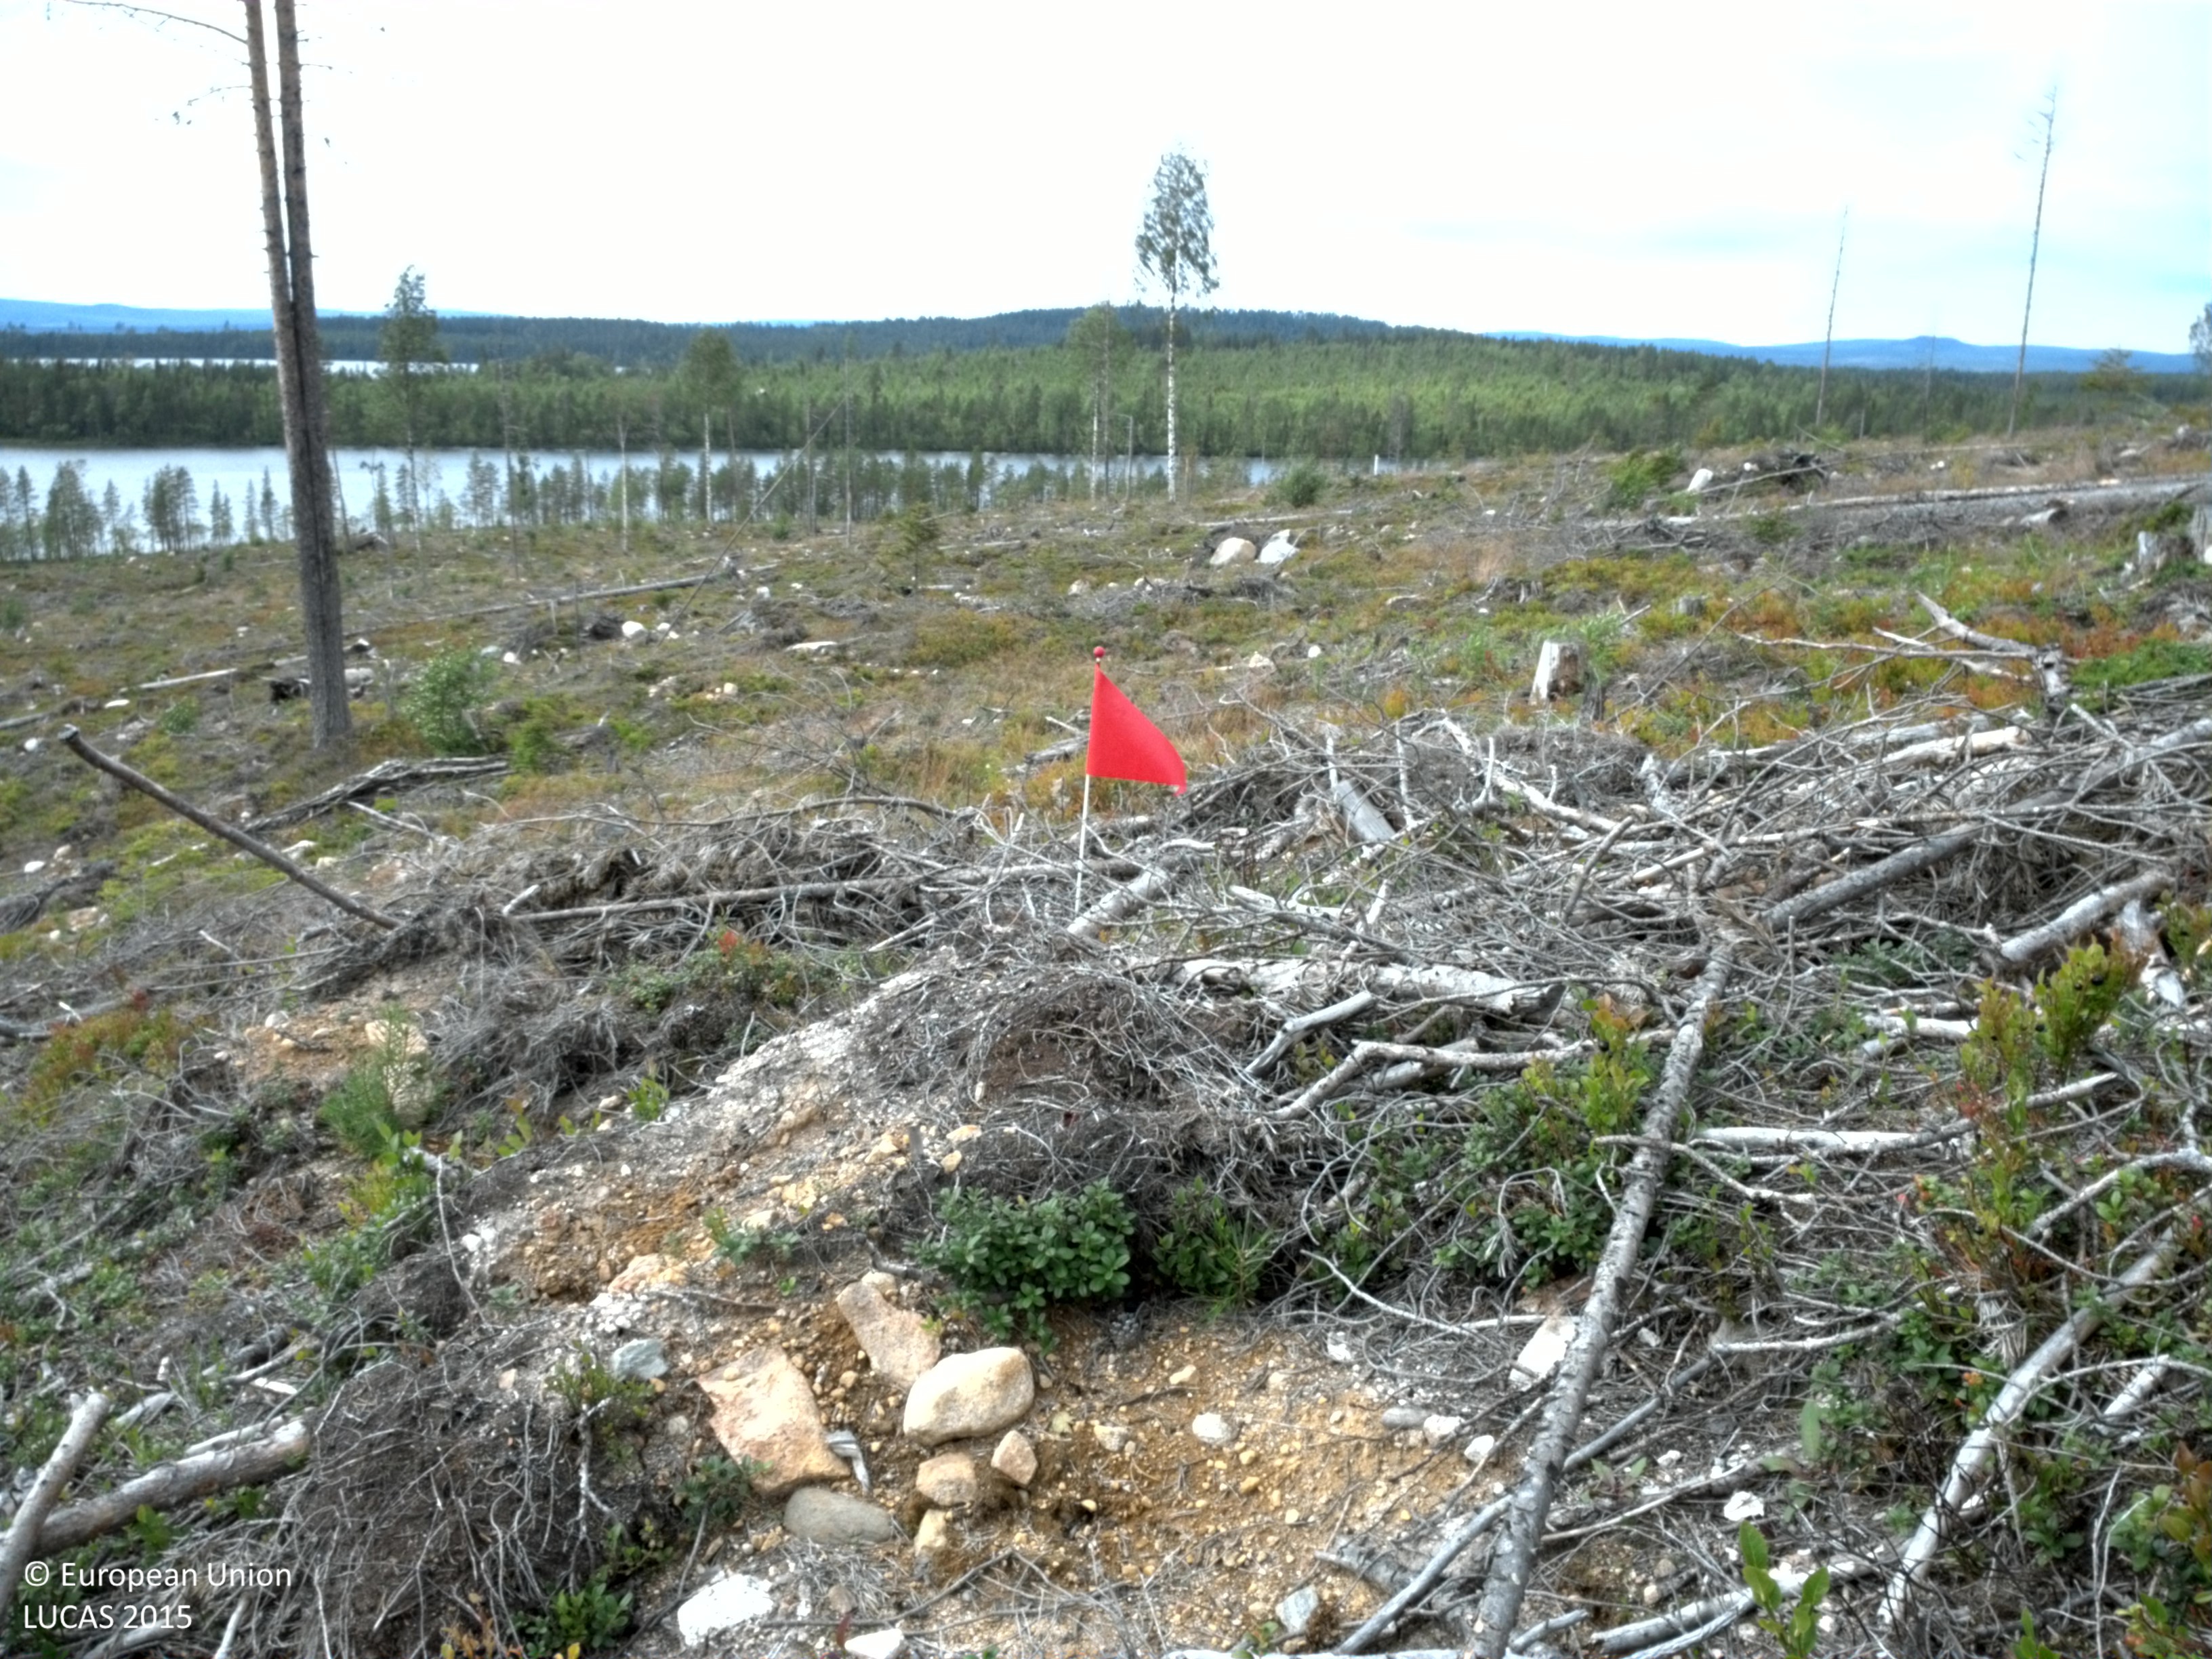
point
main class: Shrubland
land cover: Shrubland with sparse tree cover
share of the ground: > 75 %
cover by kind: shrubs 80 %, broadleaved forest trees 5 %, lichens and mosses 5 %, consolidated bare surface 5 %, unconsolidated bare surface 5 %
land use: Forestry
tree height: < 5 m
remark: Clear cut
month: August
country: SE
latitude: 66.3137
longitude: 20.5098
